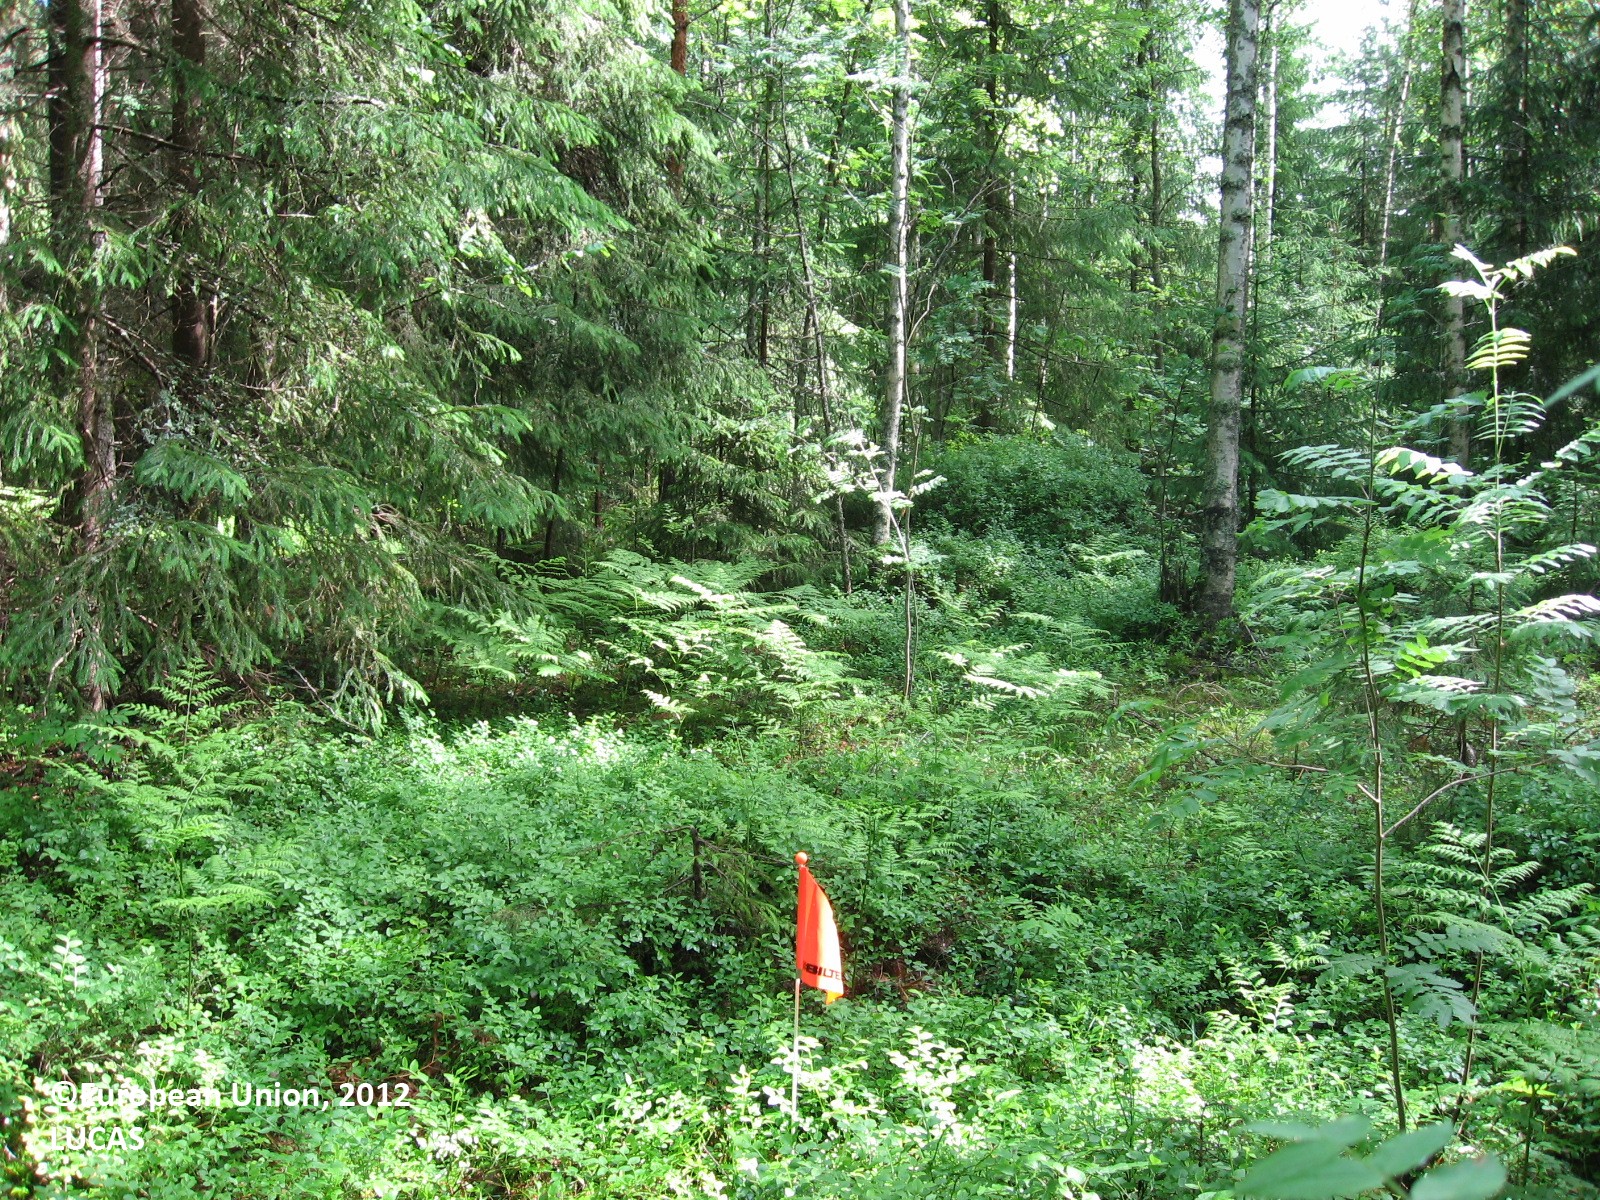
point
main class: Woodland
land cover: Spruce dominated coniferous woodland
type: boreal forest
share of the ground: 50 - 75 %
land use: Forestry
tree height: > 5 m
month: June
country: FI
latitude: 60.5706
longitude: 26.4469
